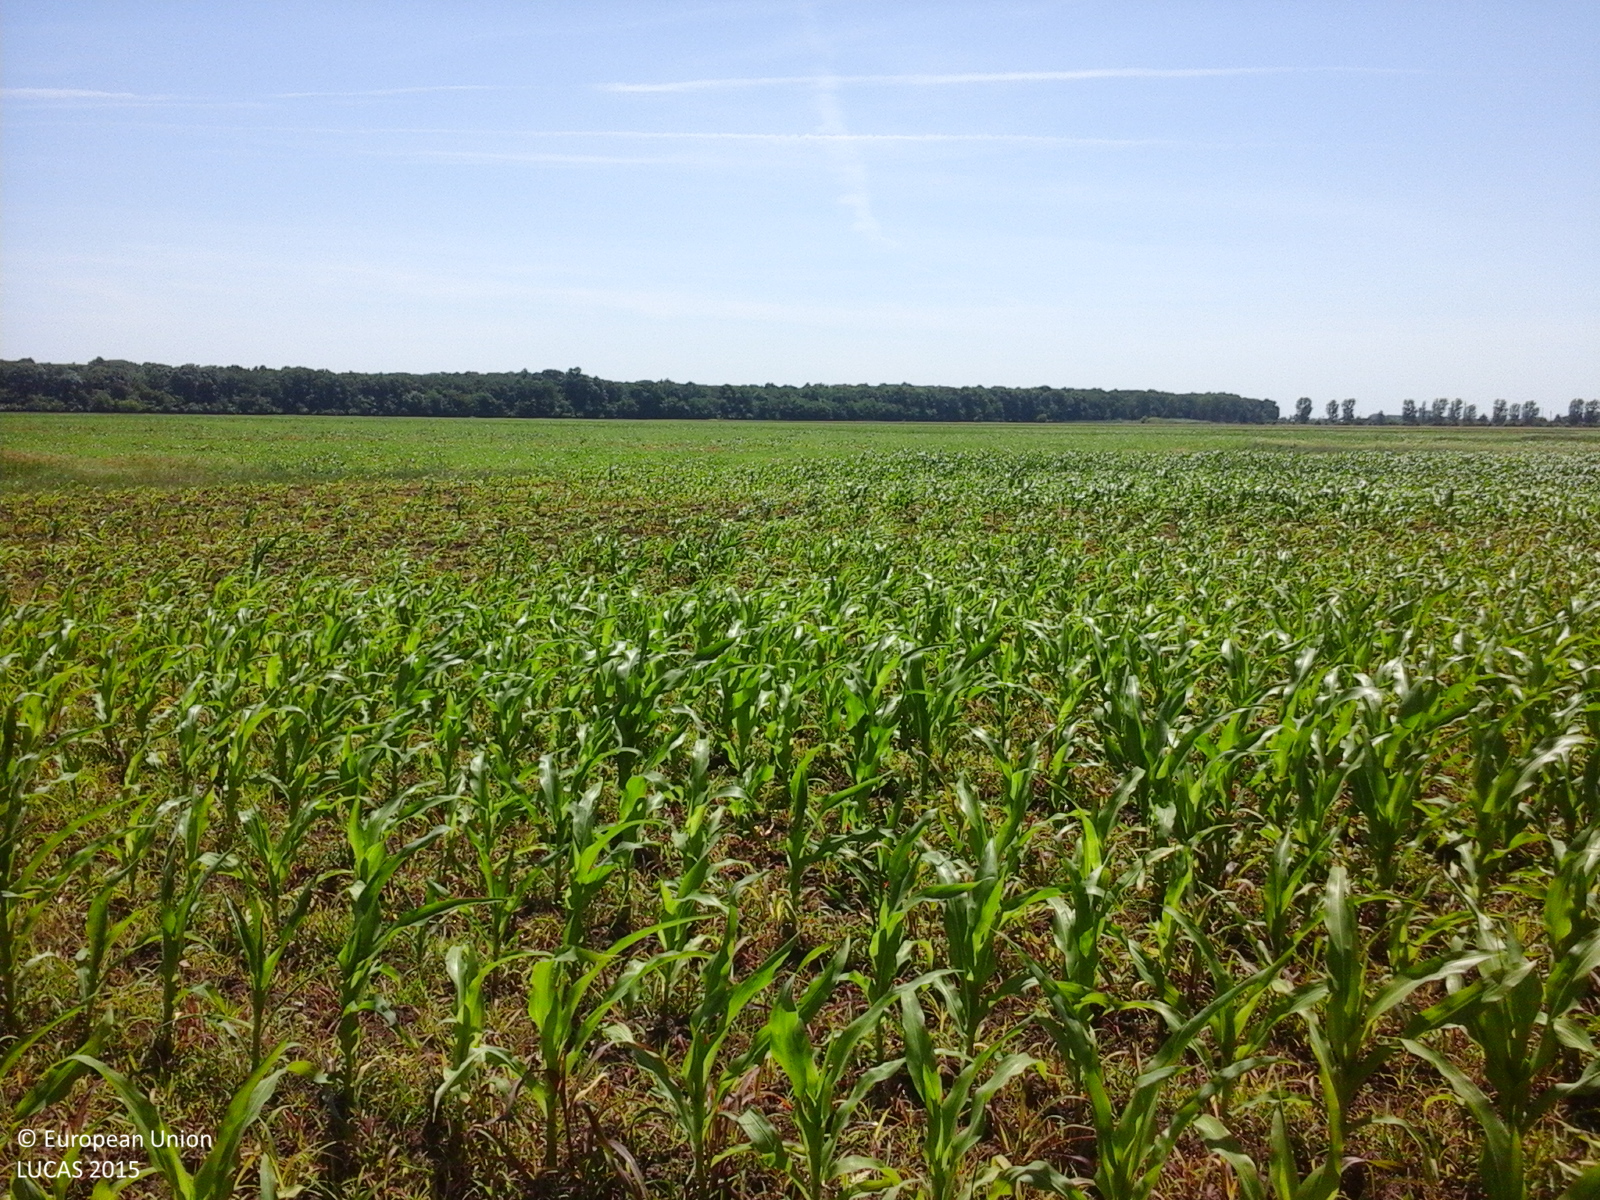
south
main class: Cropland
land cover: Maize
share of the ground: 50 - 75 %
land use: Agriculture (excluding fallow land and kitchen gardens)
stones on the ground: < 10 %
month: June
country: RO
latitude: 44.9180
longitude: 26.1095
